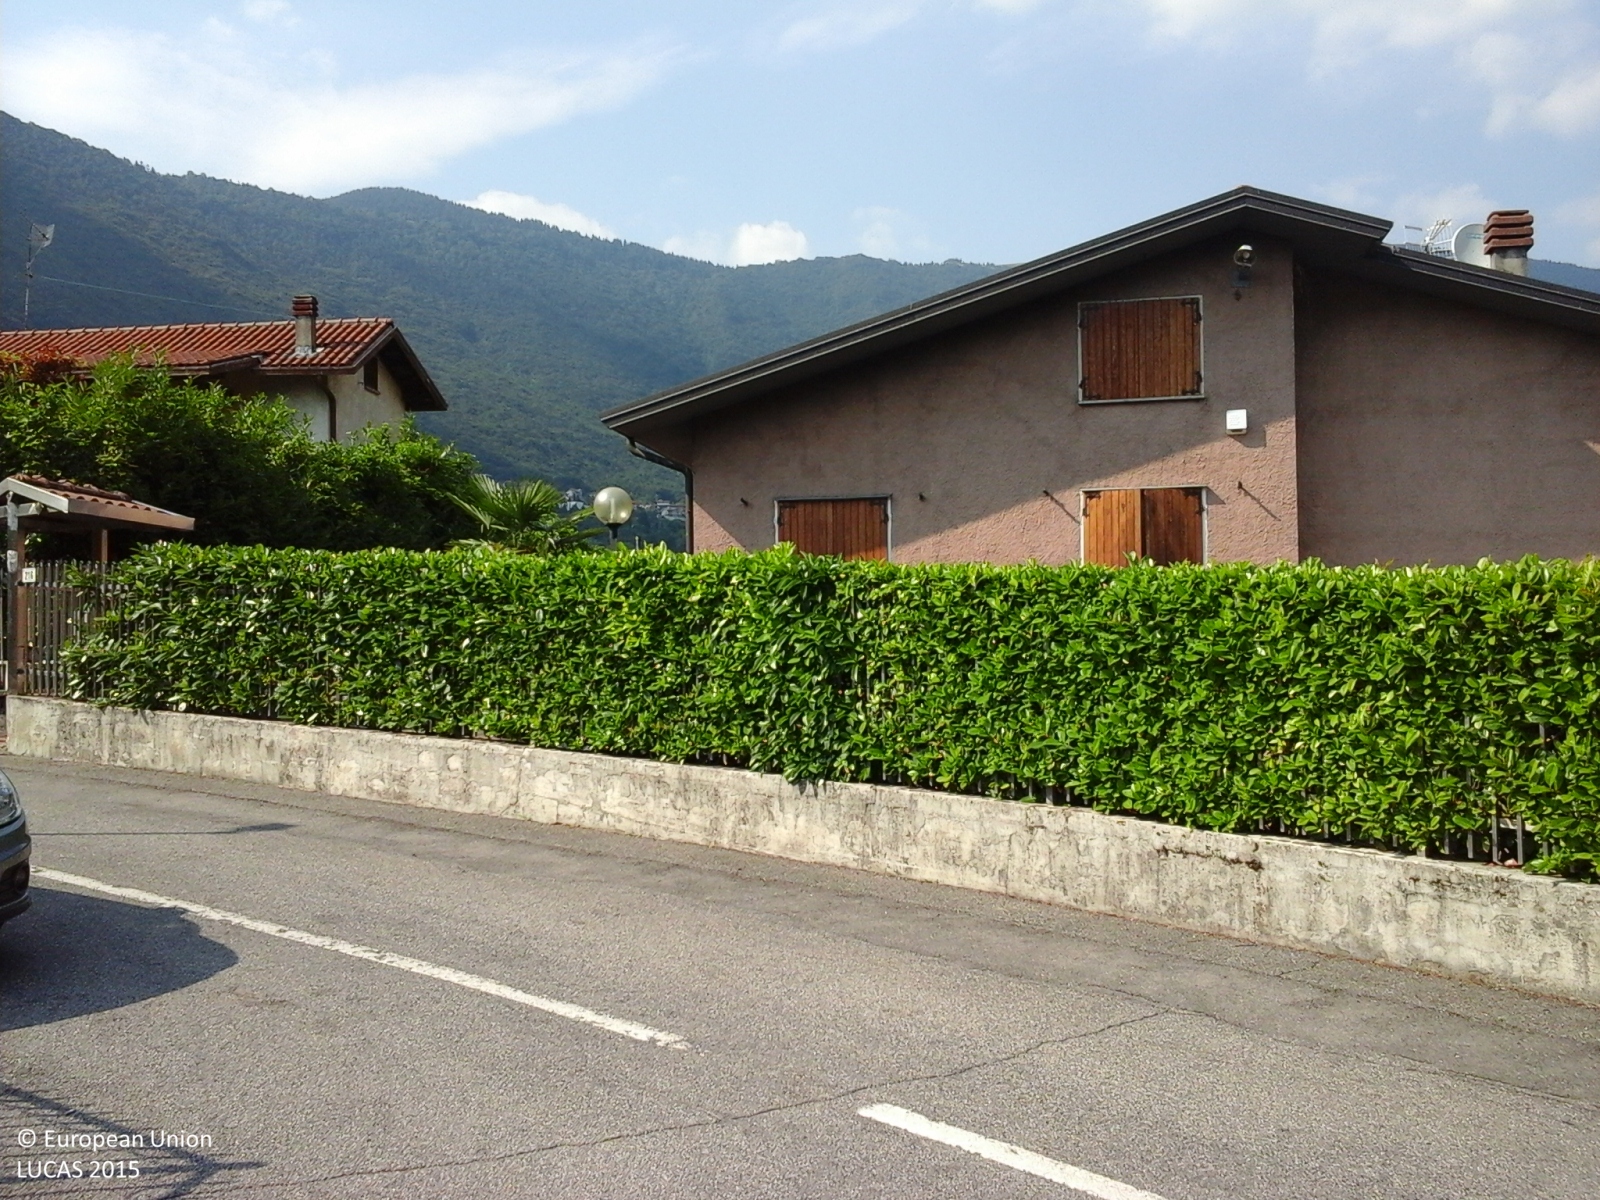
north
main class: Grassland
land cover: Grassland with sparse tree/shrub cover
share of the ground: > 75 %
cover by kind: herbaceous plants 95 %, coniferous forest trees 5 %
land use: Residential
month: June
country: IT
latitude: 45.7747
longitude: 9.9358
